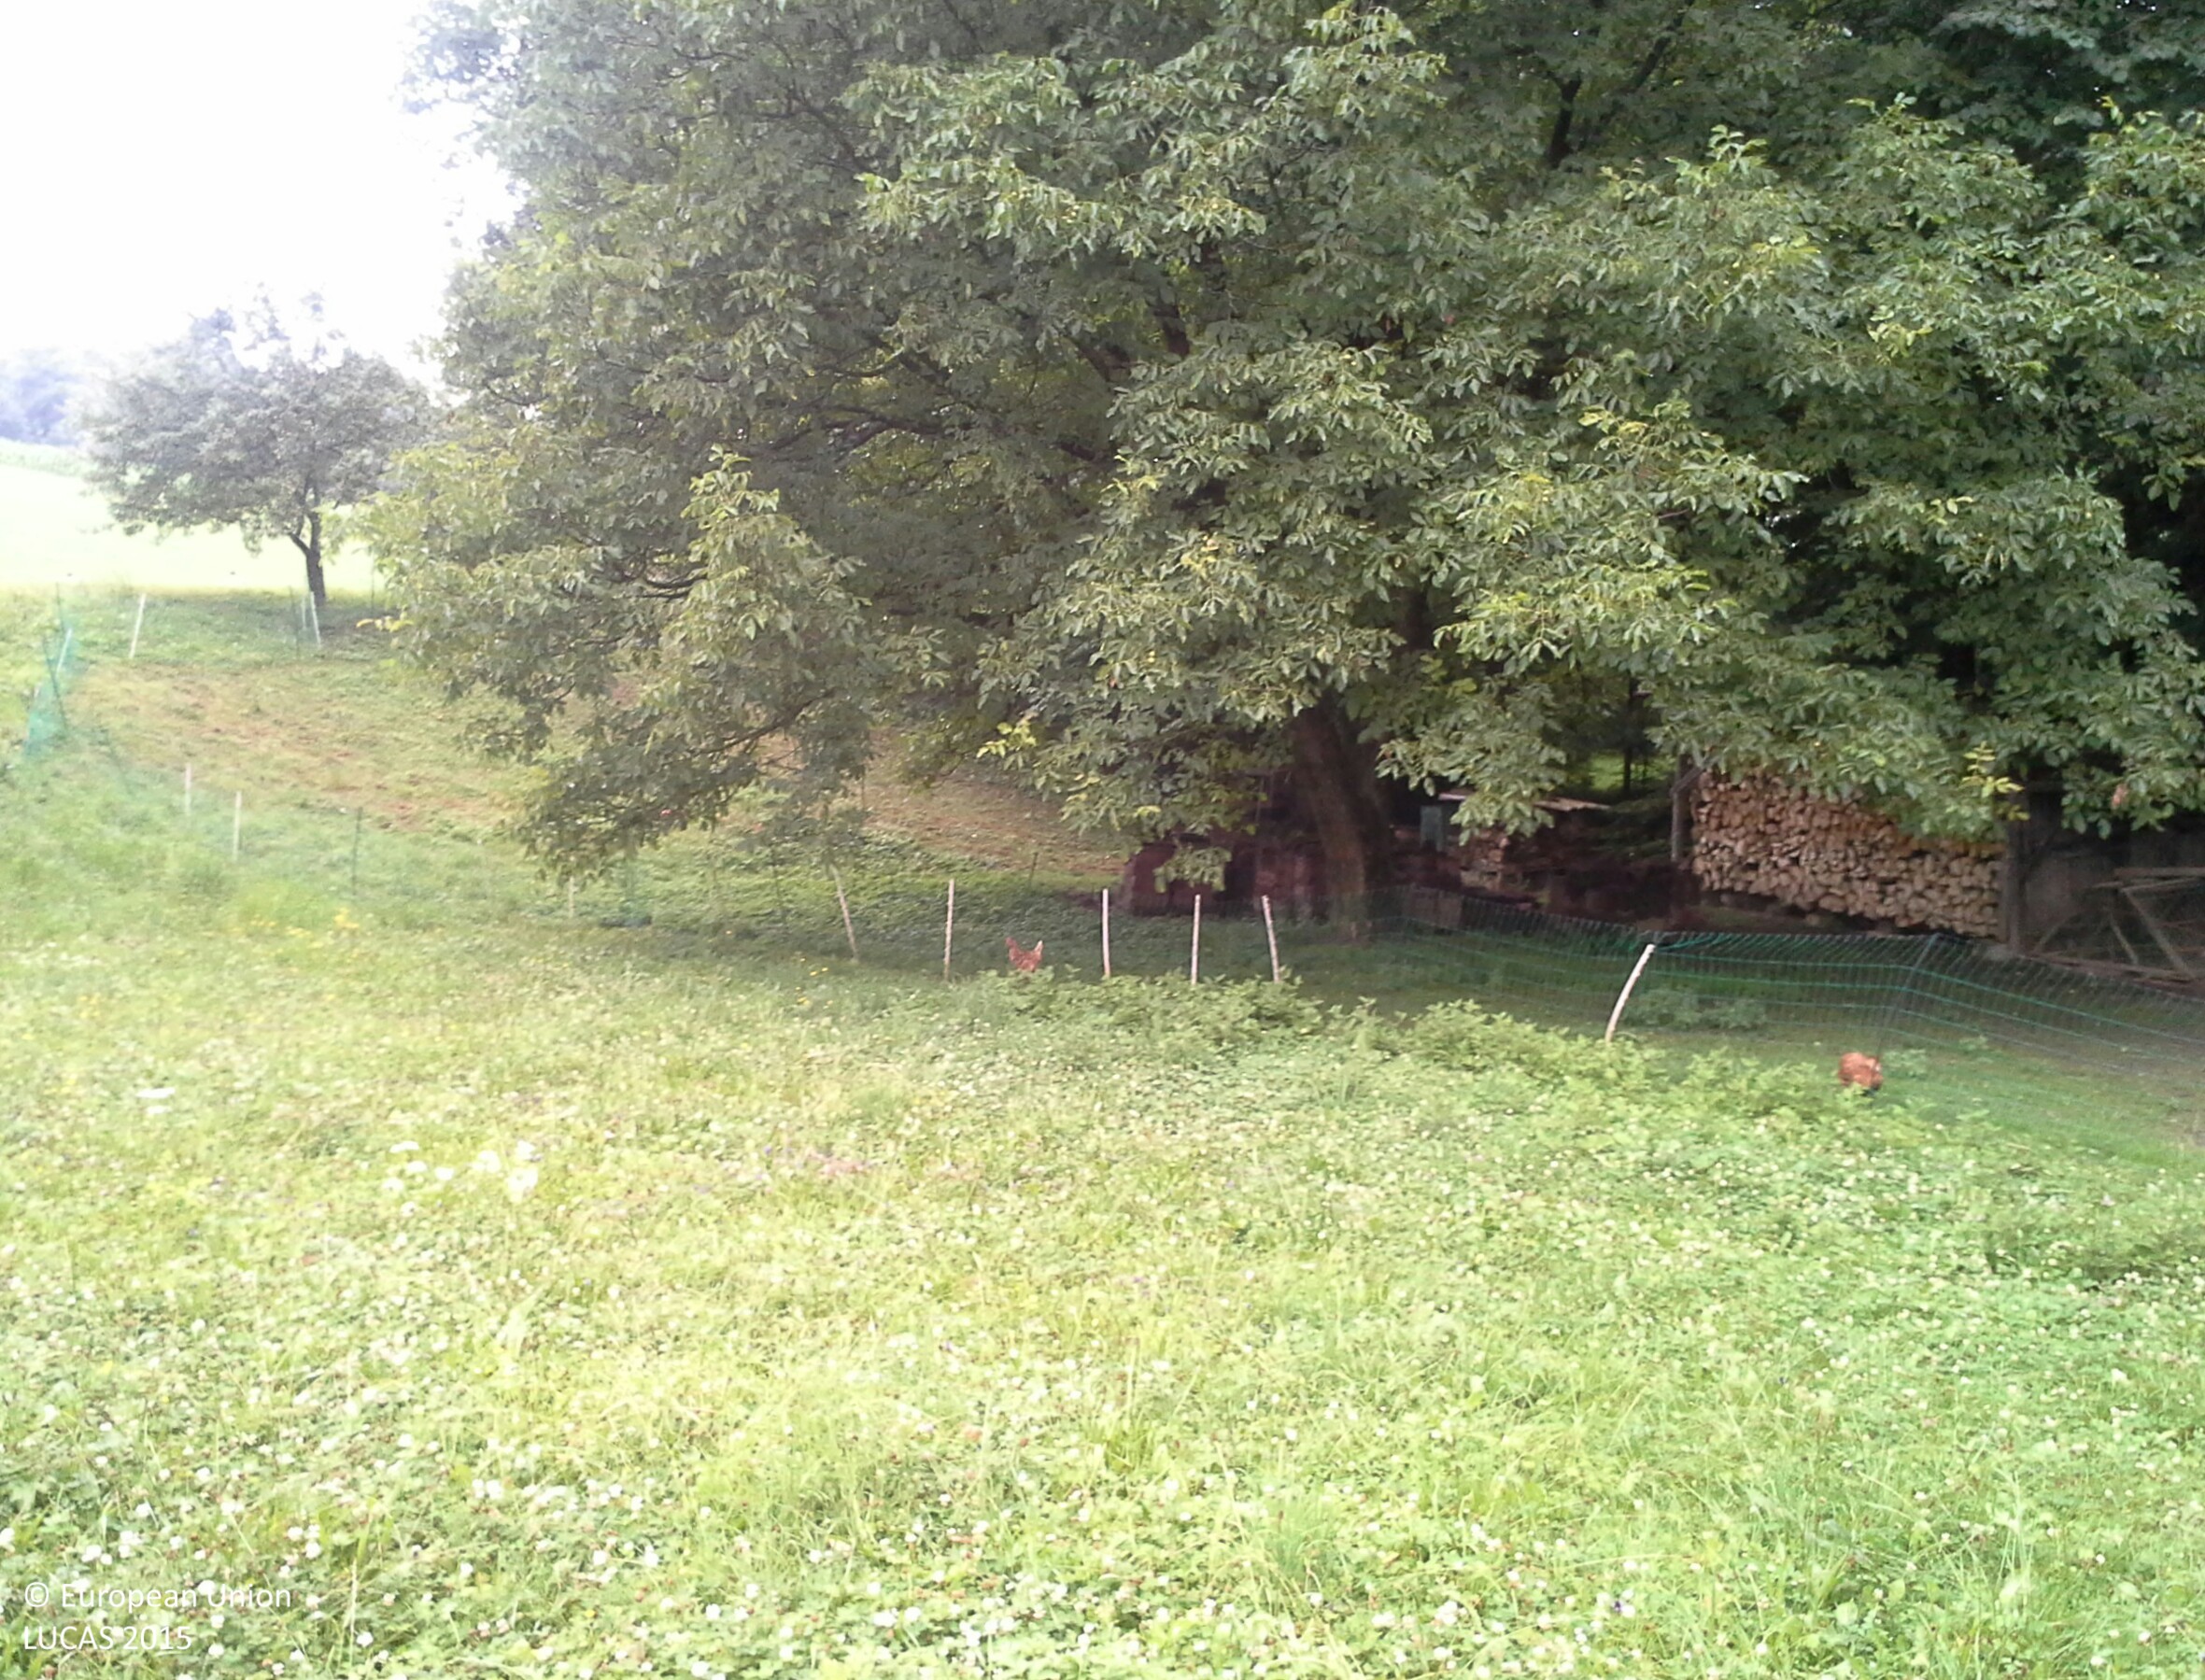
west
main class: Grassland
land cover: Grassland without tree/shrub cover
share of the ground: > 75 %
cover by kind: herbaceous plants 100 %
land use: Agriculture (excluding fallow land and kitchen gardens)
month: July
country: AT
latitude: 48.0271
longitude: 14.8415
